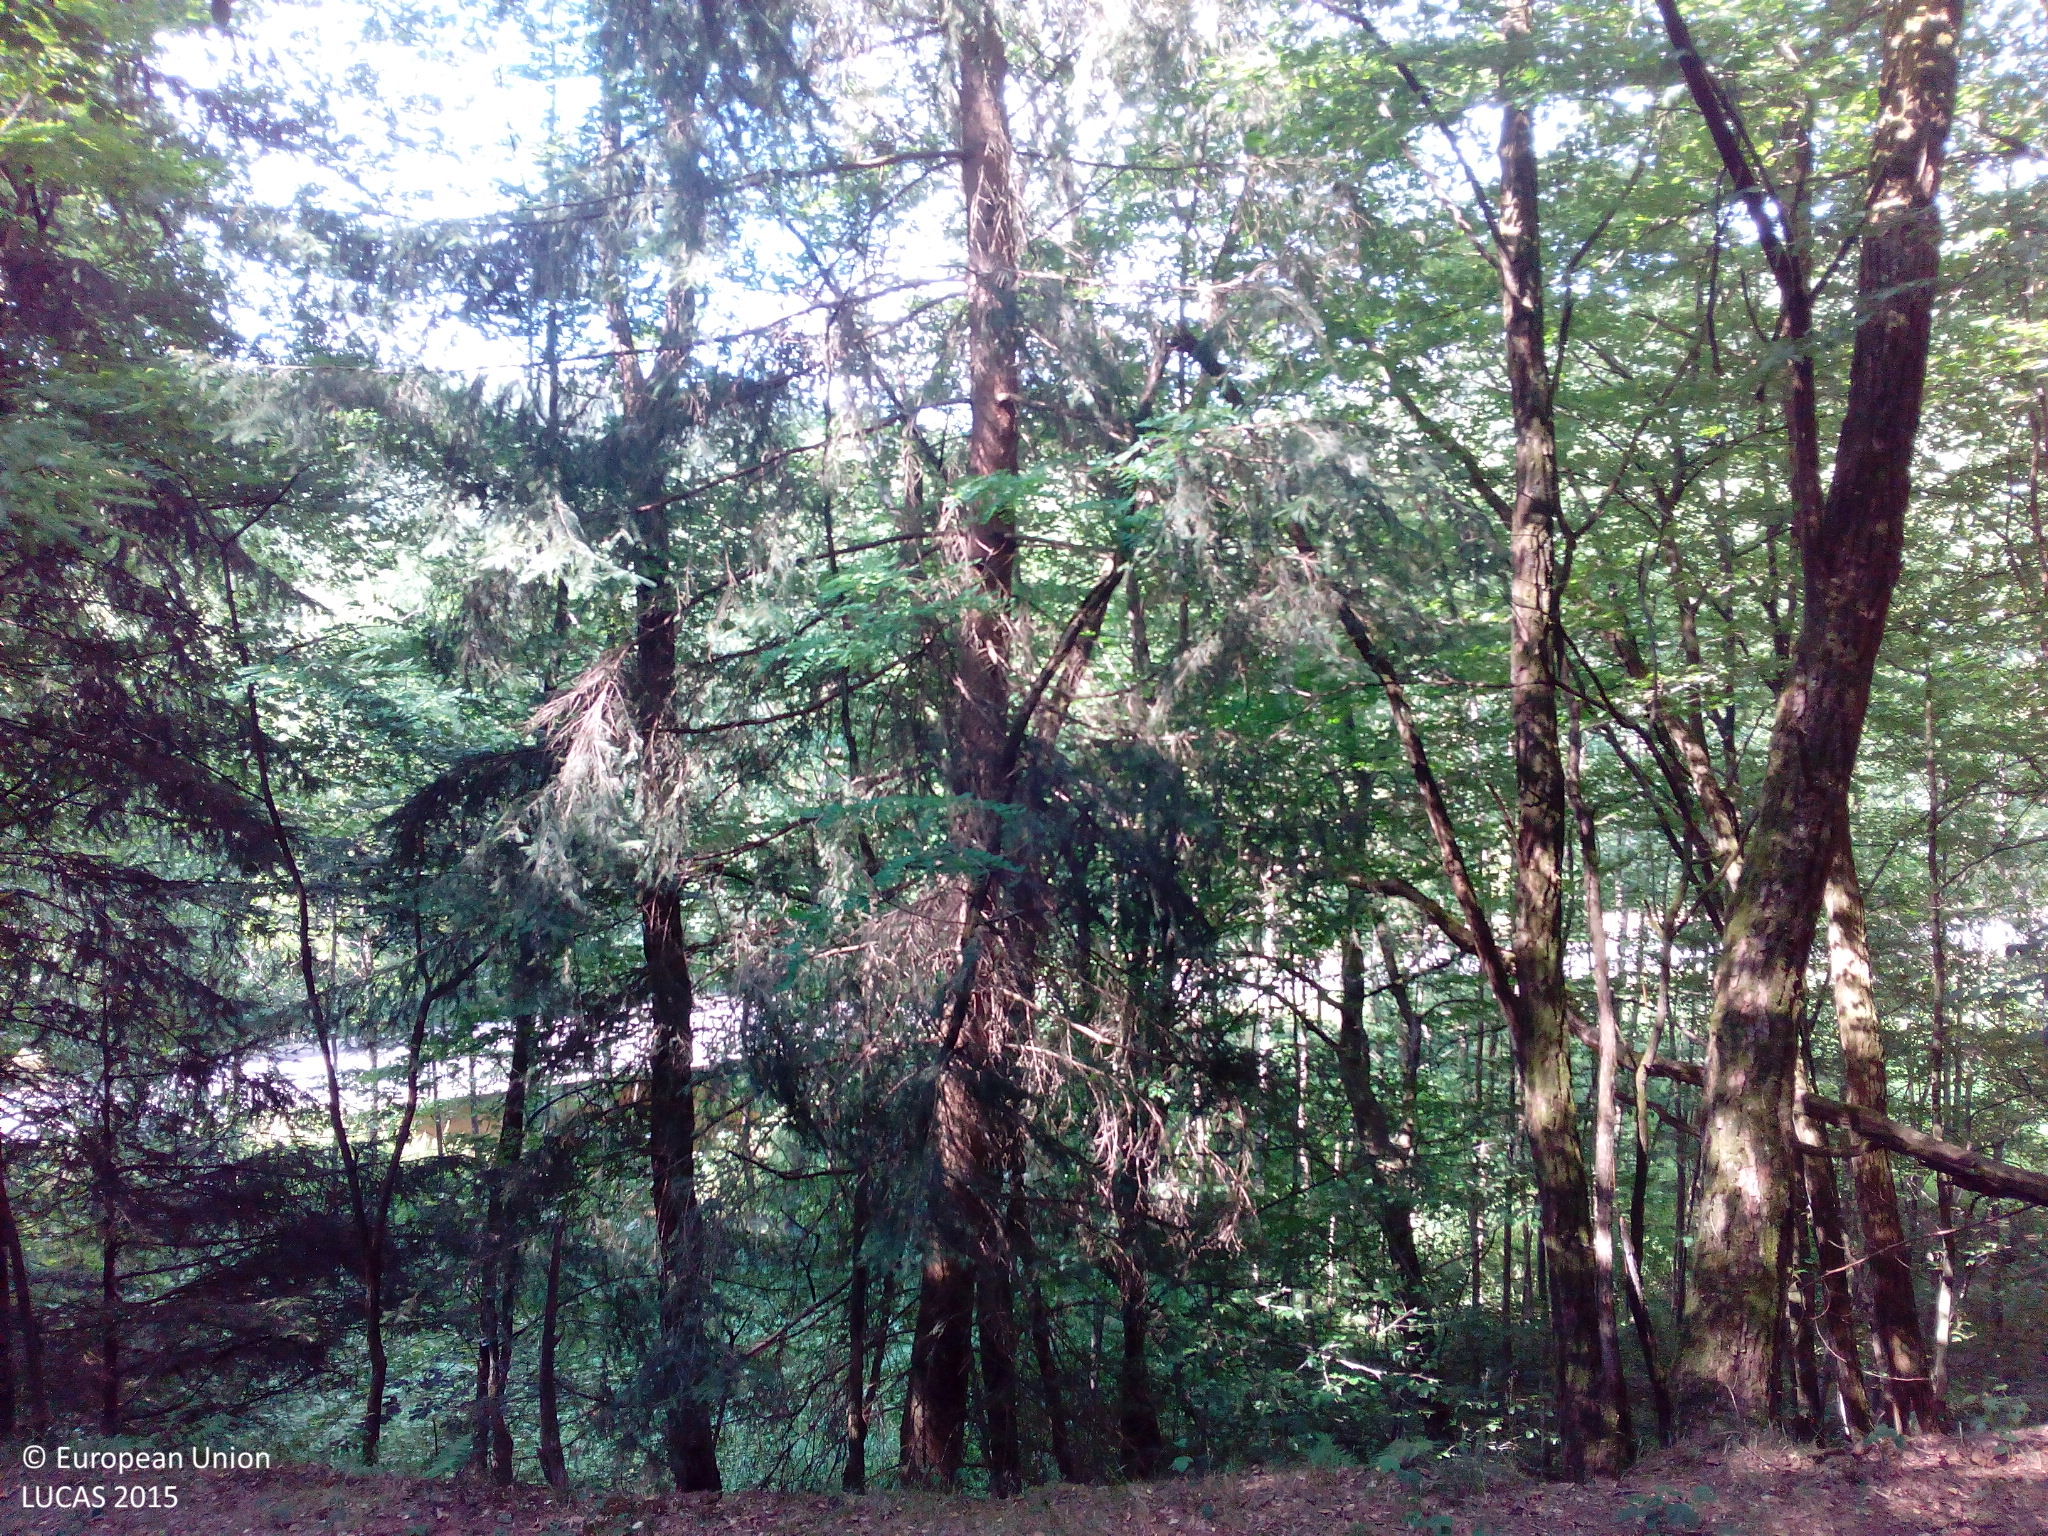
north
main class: Woodland
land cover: Spruce dominated mixed woodland
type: hemiboreal forest and nemoral coniferous forest and mixed broadleaved-coniferous forest
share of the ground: > 75 %
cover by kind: coniferous forest trees 60 %, broadleaved forest trees 20 %, unconsolidated bare surface 10 %, shrubs 5 %, herbaceous plants 5 %
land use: Forestry
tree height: > 5 m
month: July
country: DE
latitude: 49.1317
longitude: 7.5199
